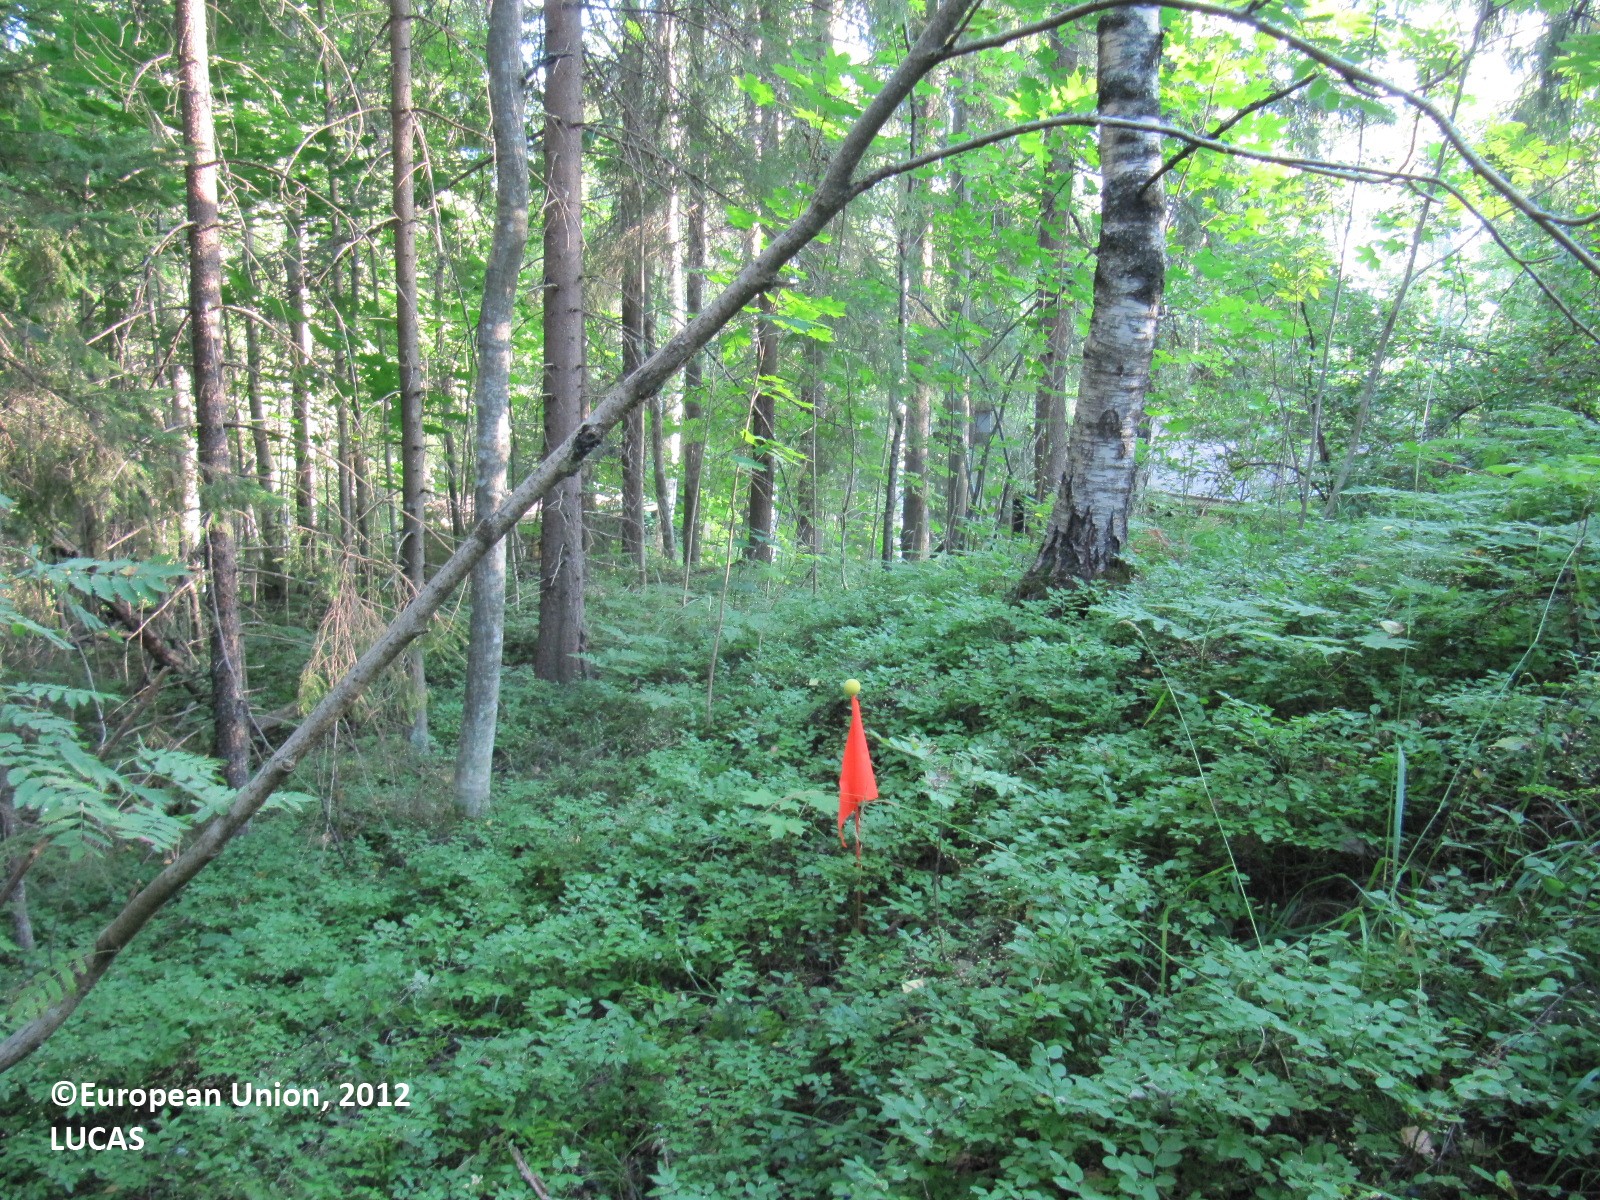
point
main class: Woodland
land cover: Spruce dominated mixed woodland
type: boreal forest
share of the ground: > 75 %
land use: Forestry
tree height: > 5 m
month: August
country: FI
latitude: 60.5426
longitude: 24.5261
